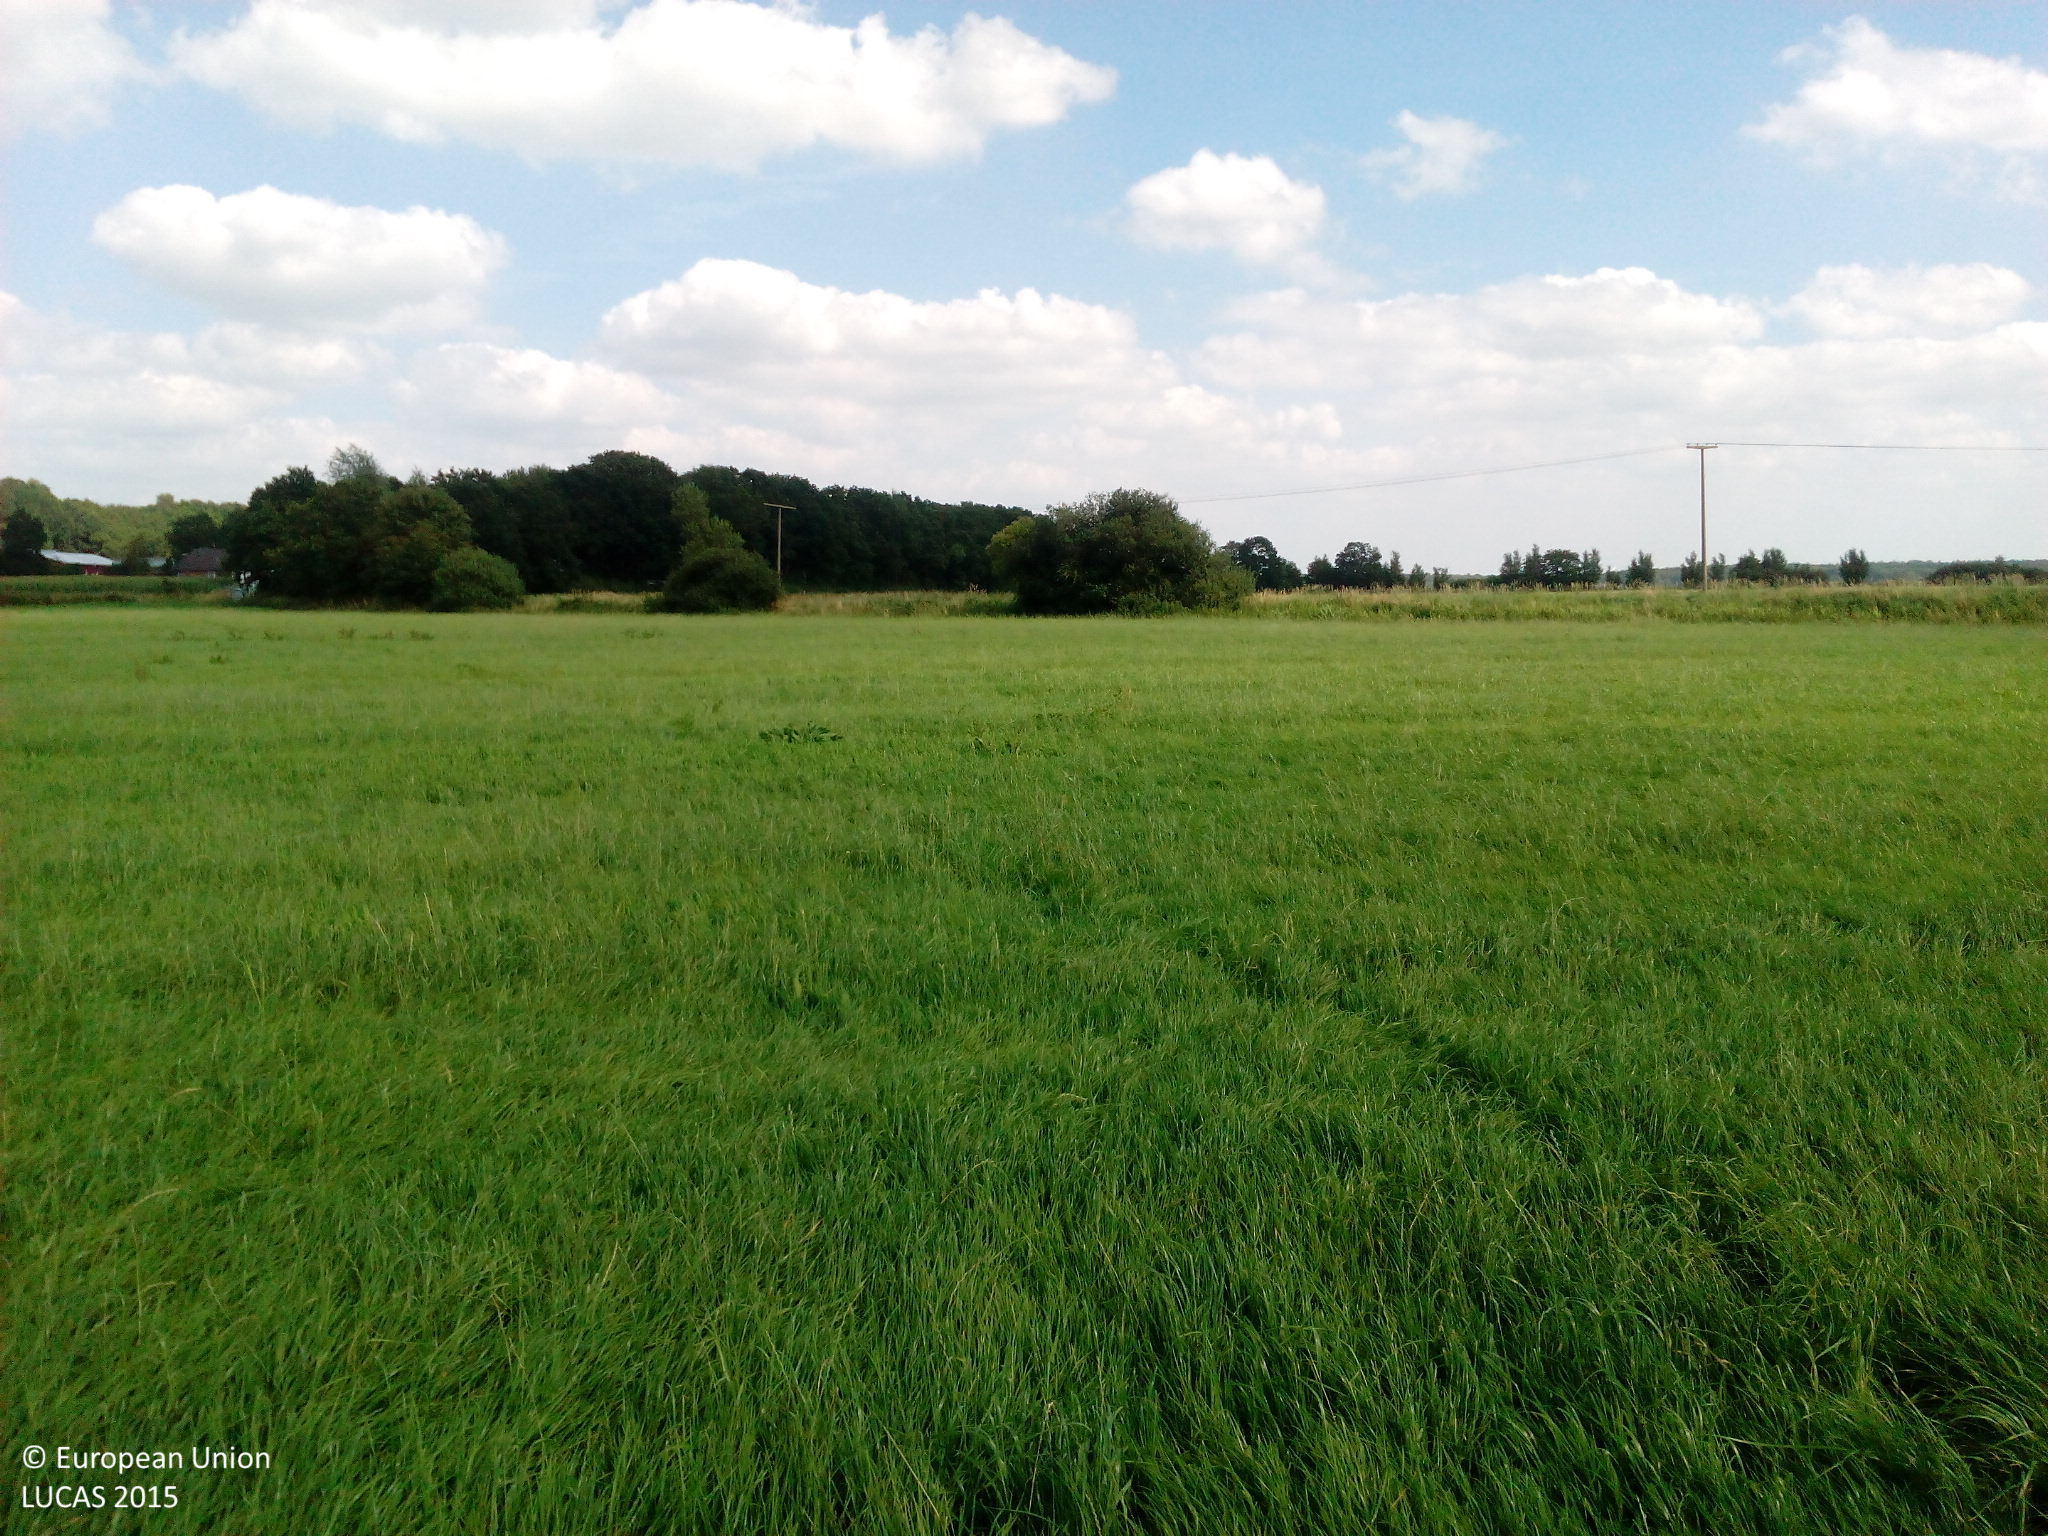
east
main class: Grassland
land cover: Grassland without tree/shrub cover
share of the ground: > 75 %
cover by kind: herbaceous plants 100 %
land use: Agriculture (excluding fallow land and kitchen gardens)
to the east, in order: Grassland without tree/shrub cover; Ditches and canals; Shrubland with sparse tree cover; Tracks; Grass margins; Ditches and canals; Fences; Grassland without tree/shrub cover; Electric lines; Grassland without tree/shrub cover
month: August
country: DE
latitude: 54.0110
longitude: 9.3137
